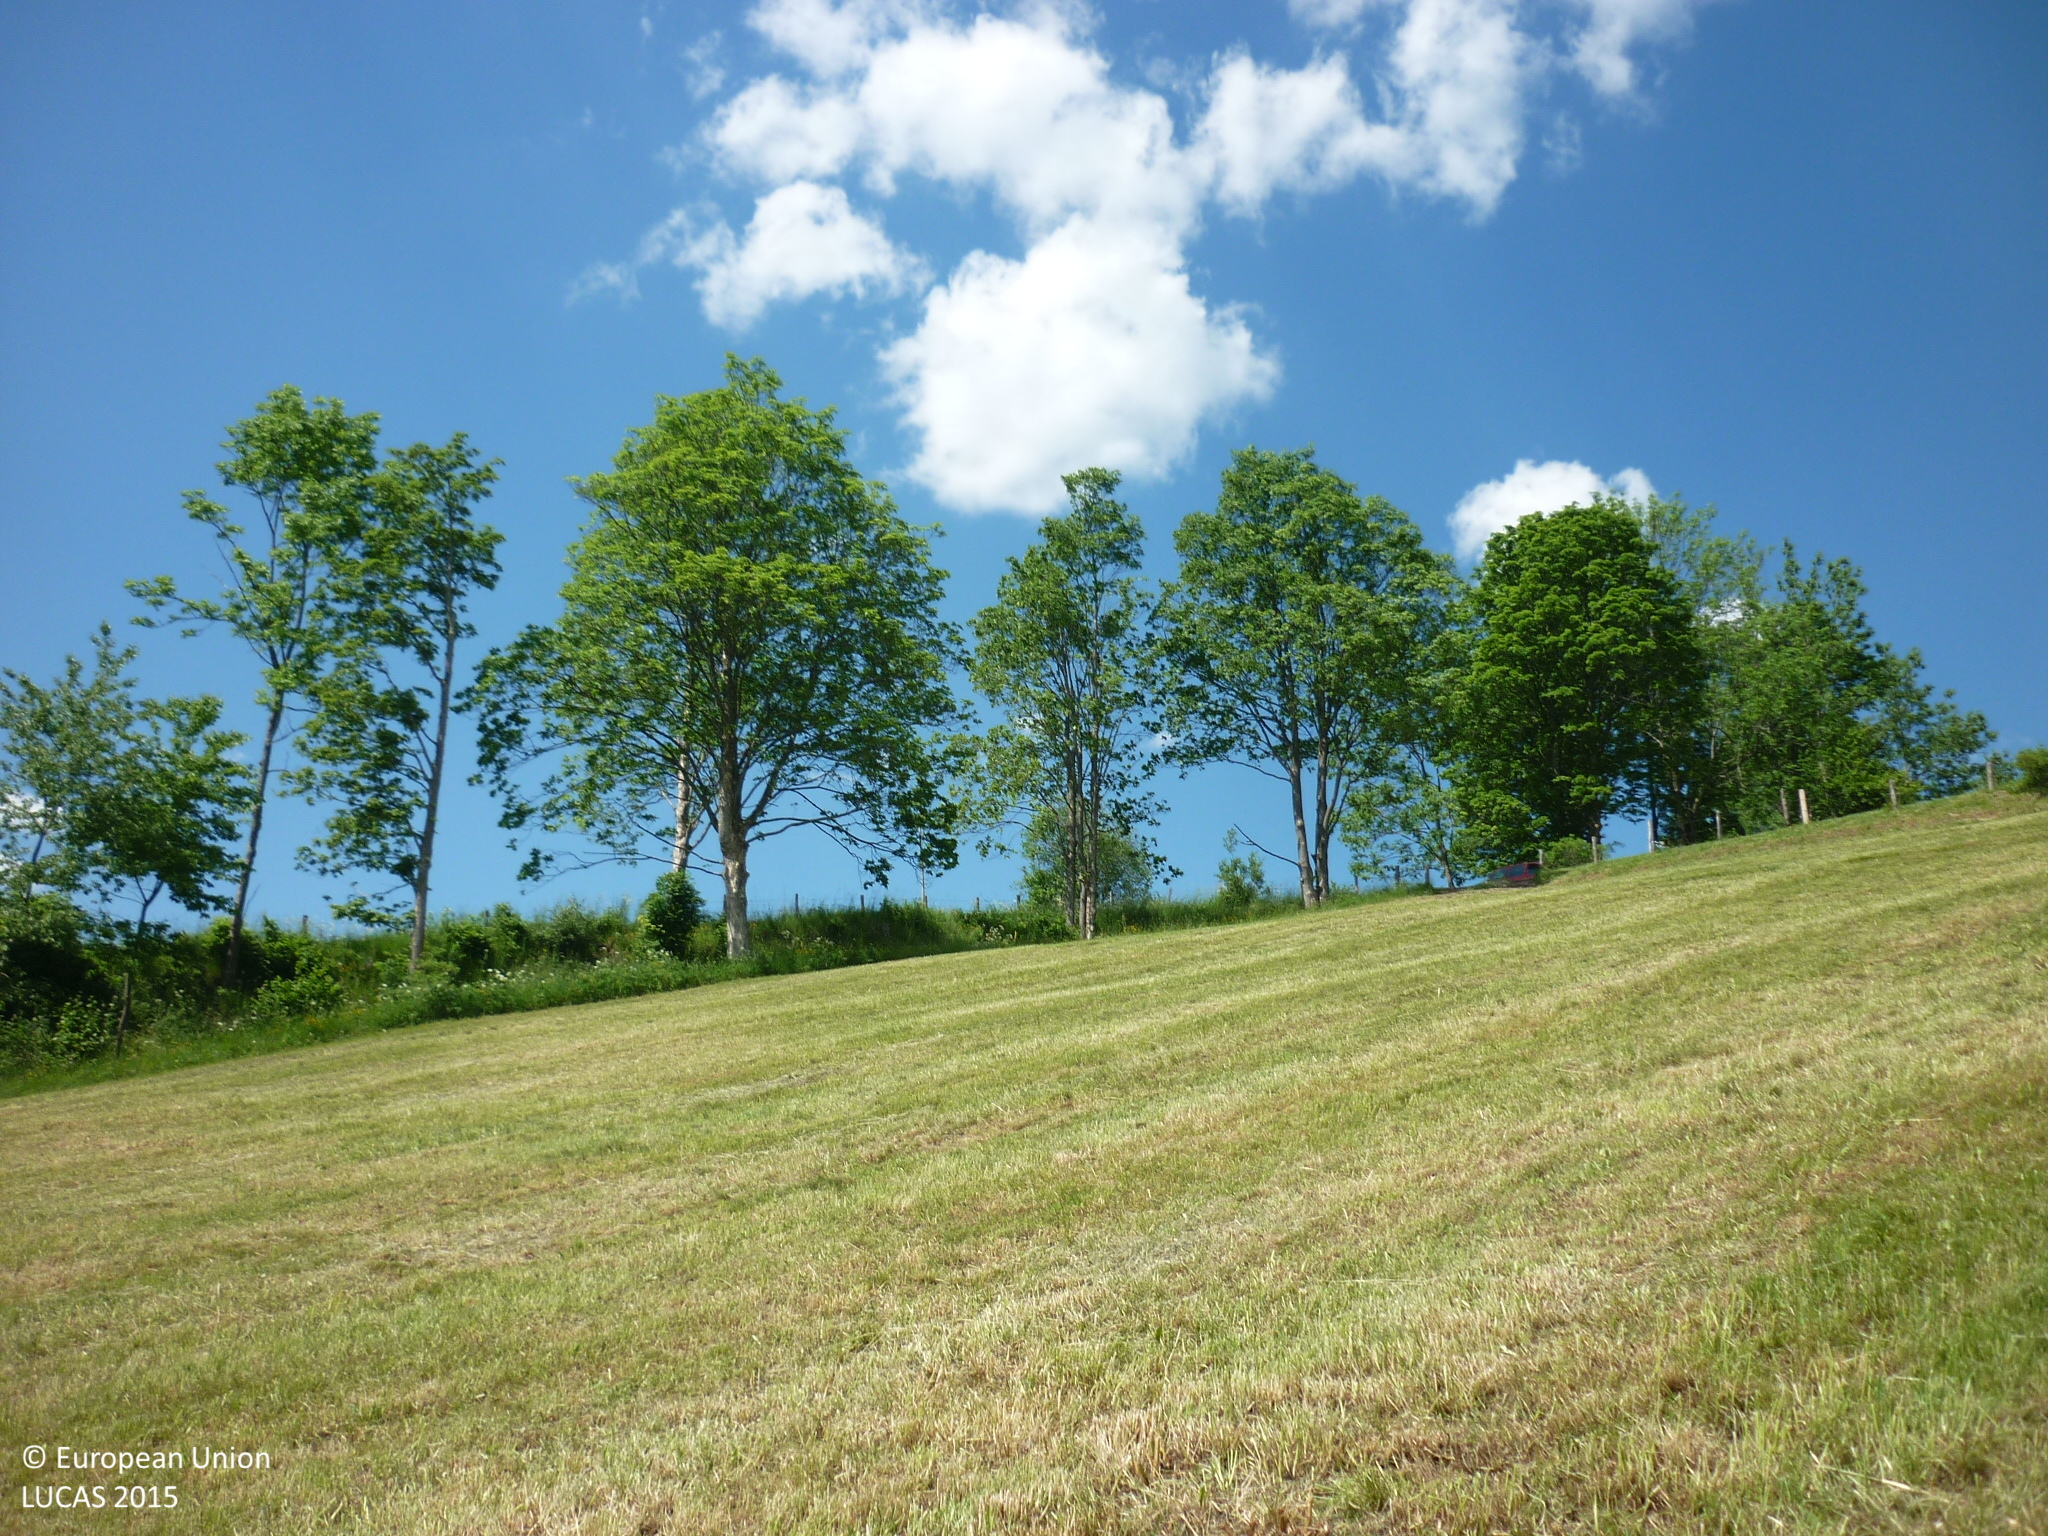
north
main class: Grassland
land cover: Grassland without tree/shrub cover
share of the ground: > 75 %
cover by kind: herbaceous plants 100 %
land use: Agriculture (excluding fallow land and kitchen gardens)
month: June
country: AT
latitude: 47.1731
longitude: 14.1279
